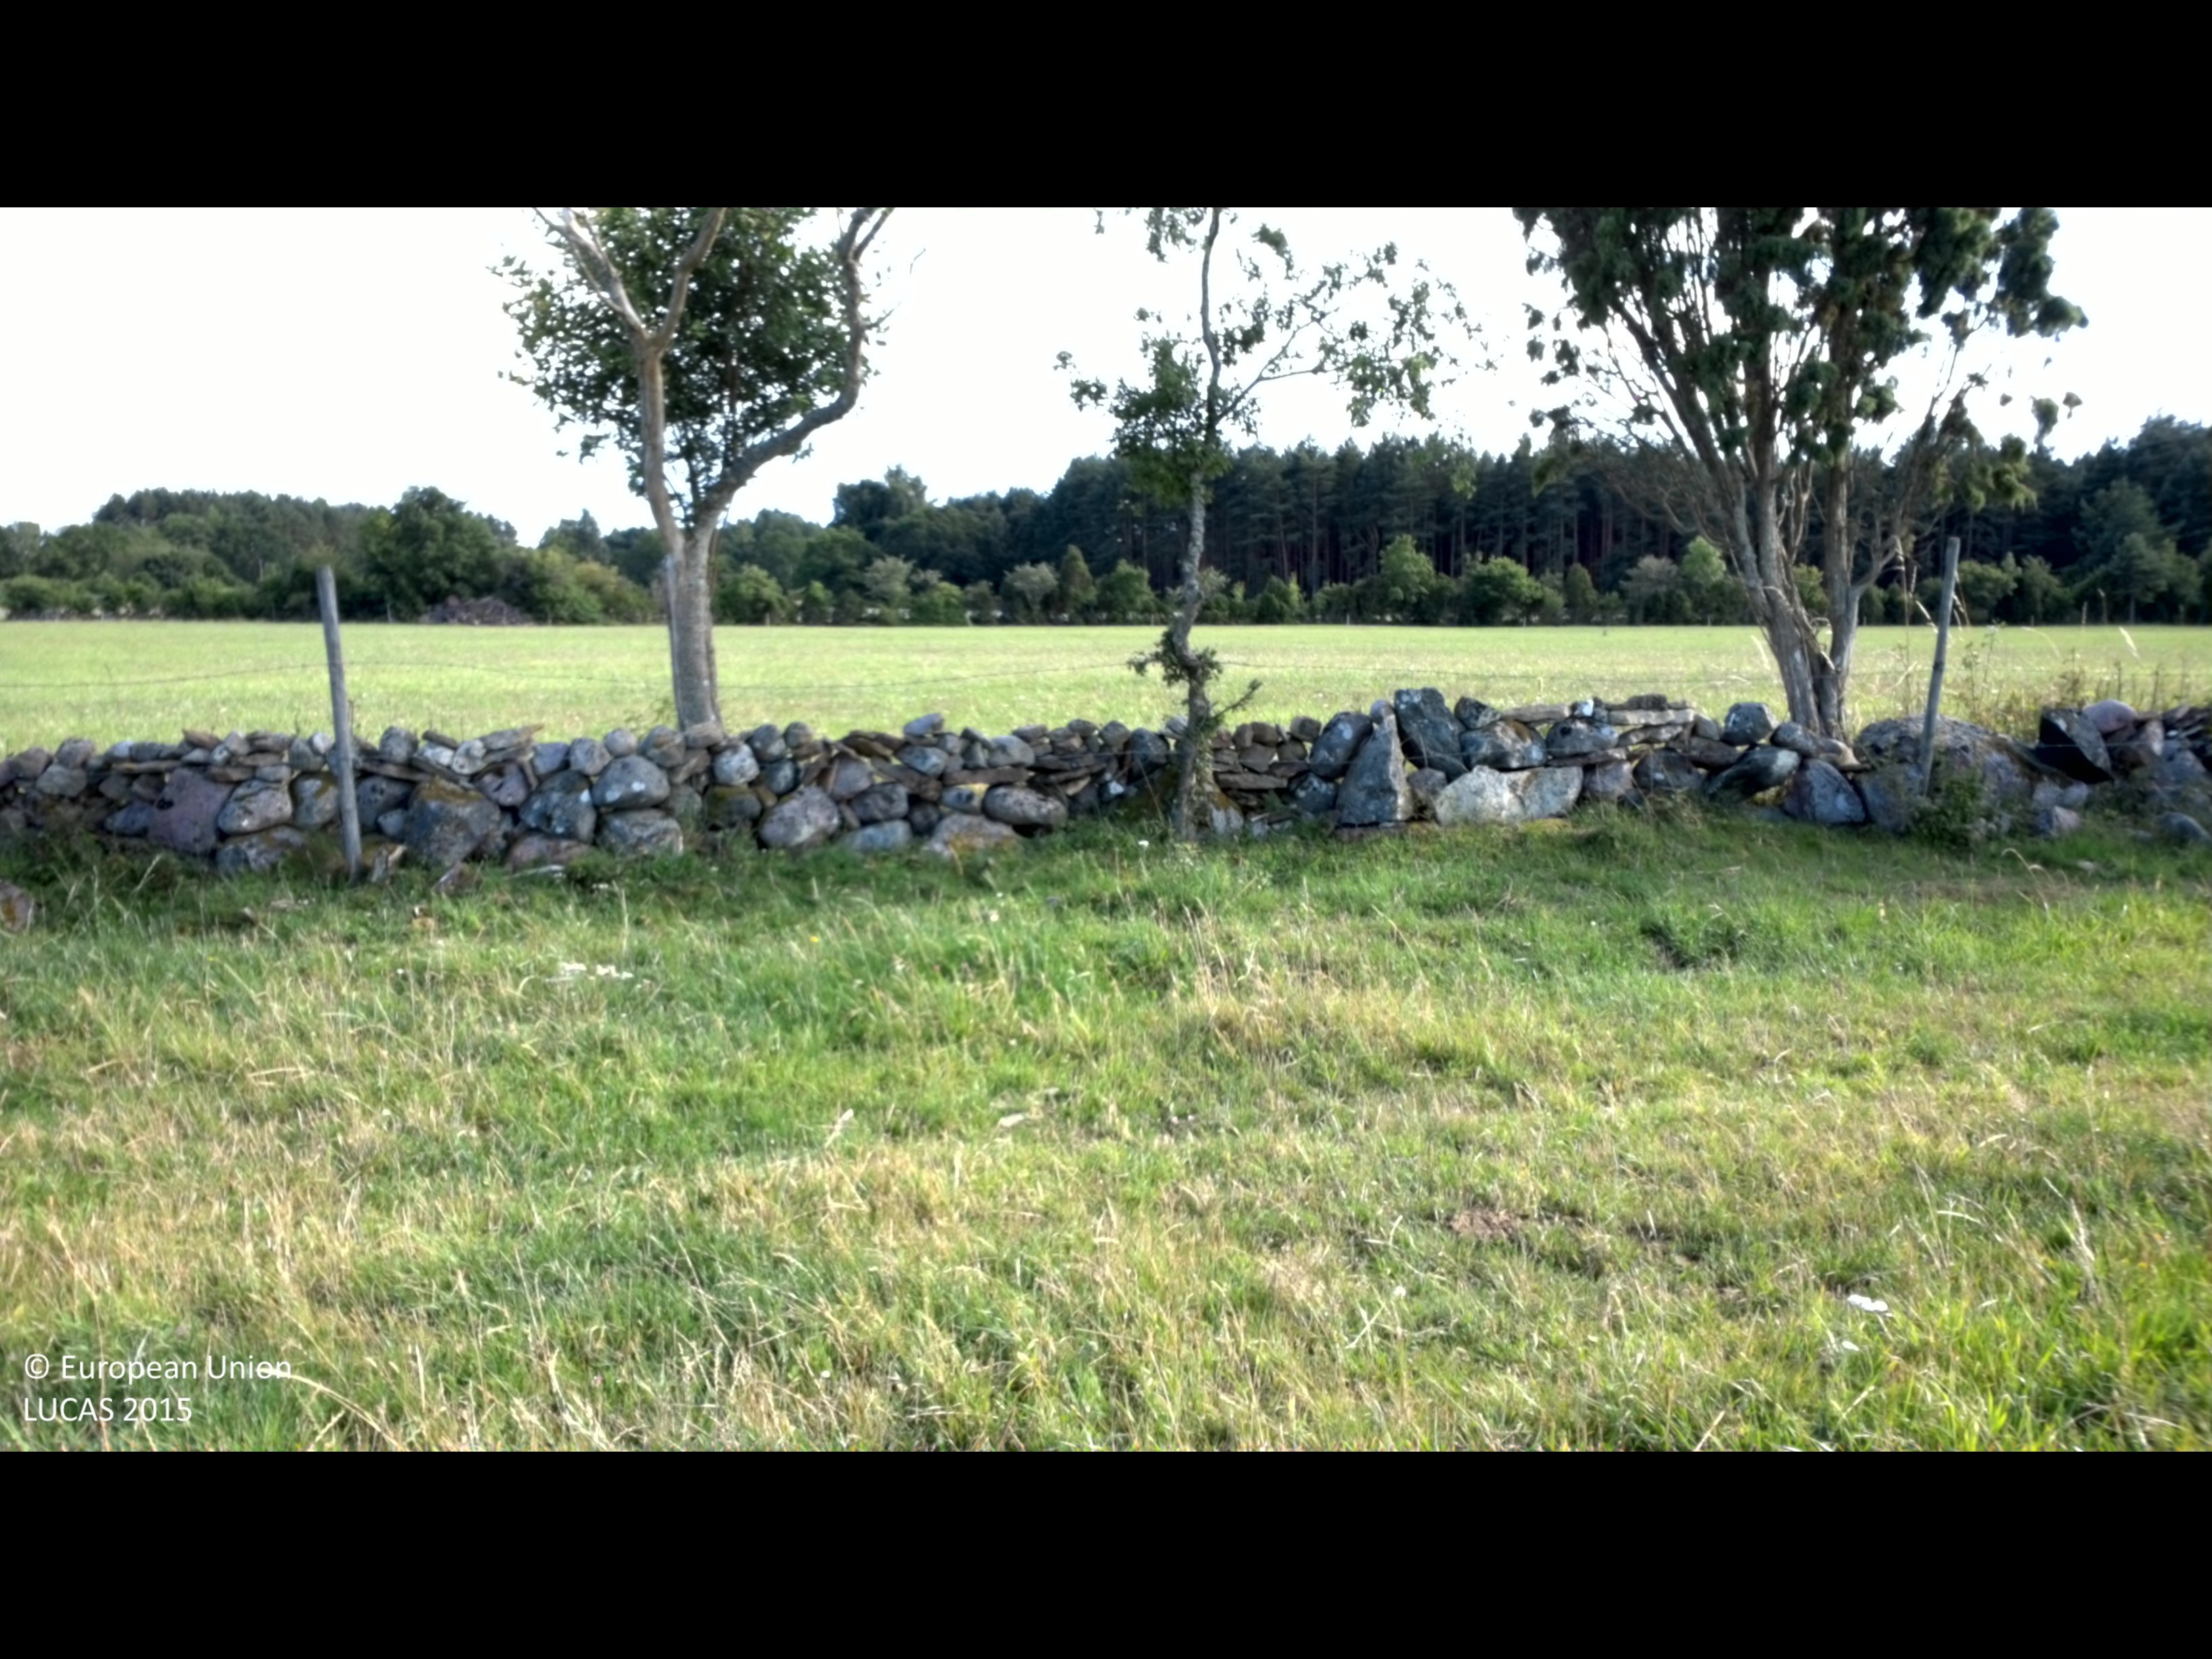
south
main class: Grassland
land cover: Grassland without tree/shrub cover
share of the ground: > 75 %
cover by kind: herbaceous plants 100 %
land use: Agriculture (excluding fallow land and kitchen gardens)
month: July
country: SE
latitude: 57.1899
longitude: 16.9680
